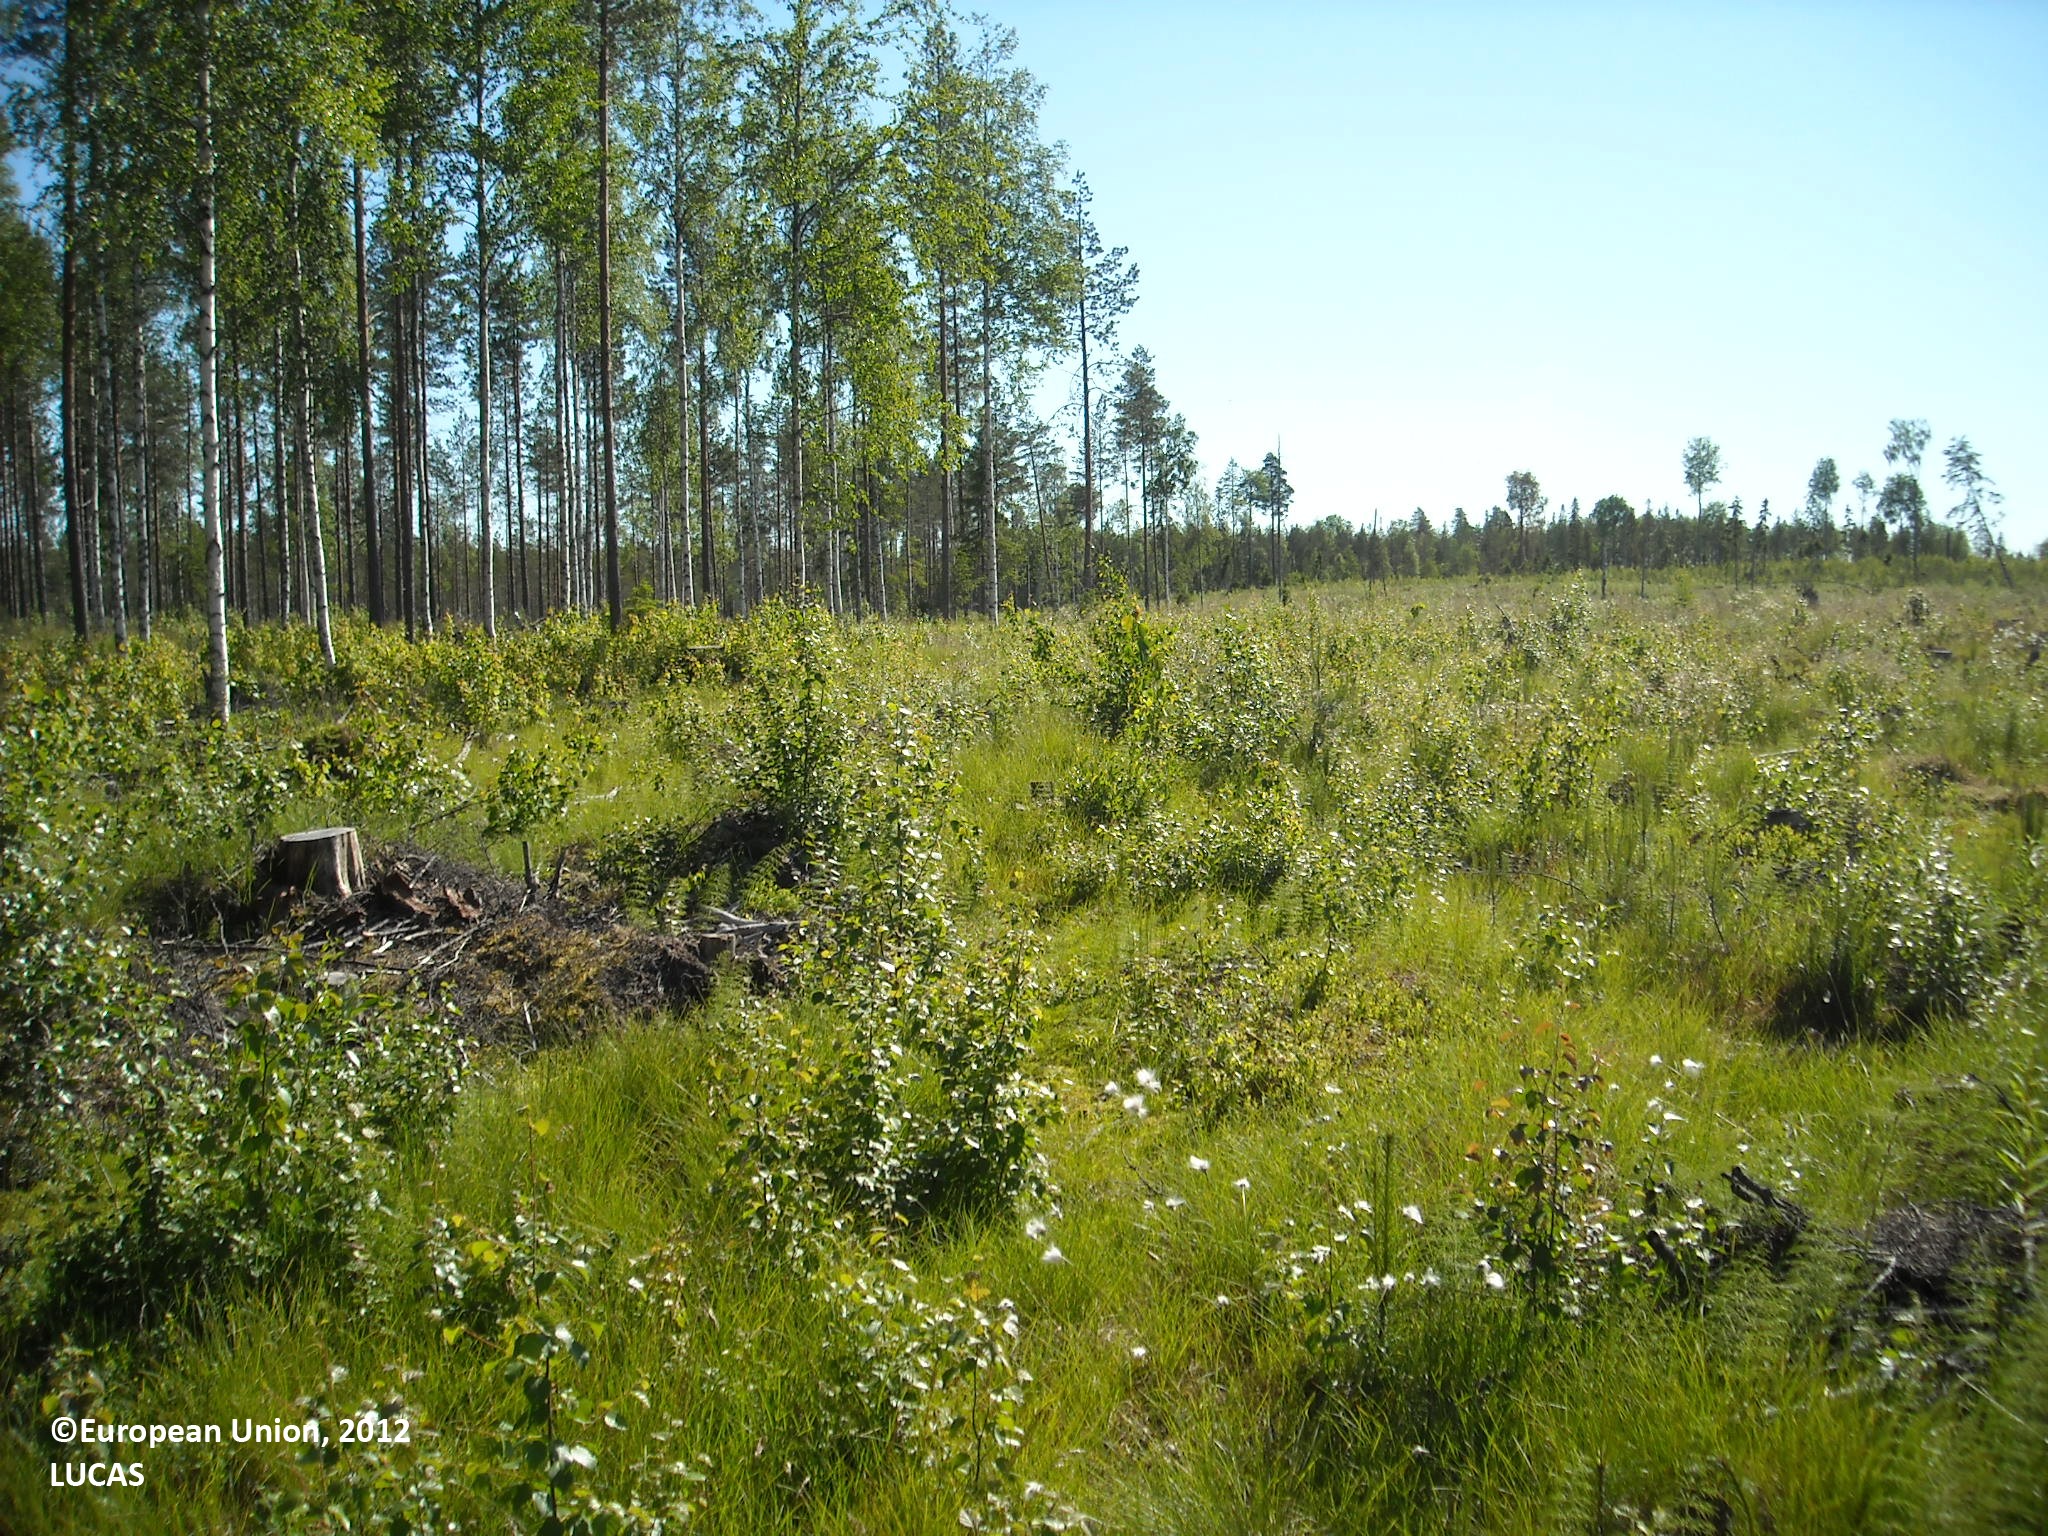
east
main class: Woodland
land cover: Pine dominated coniferous woodland
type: boreal forest
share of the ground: 25 - 50 %
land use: Forestry
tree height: > 5 m
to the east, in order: Pine dominated coniferous woodland; Shrubland with sparse tree cover; Pine dominated mixed woodland; Ditches and canals; Pine dominated mixed woodland; Shrubland with sparse tree cover
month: July
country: FI
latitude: 64.9215
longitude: 27.4971
